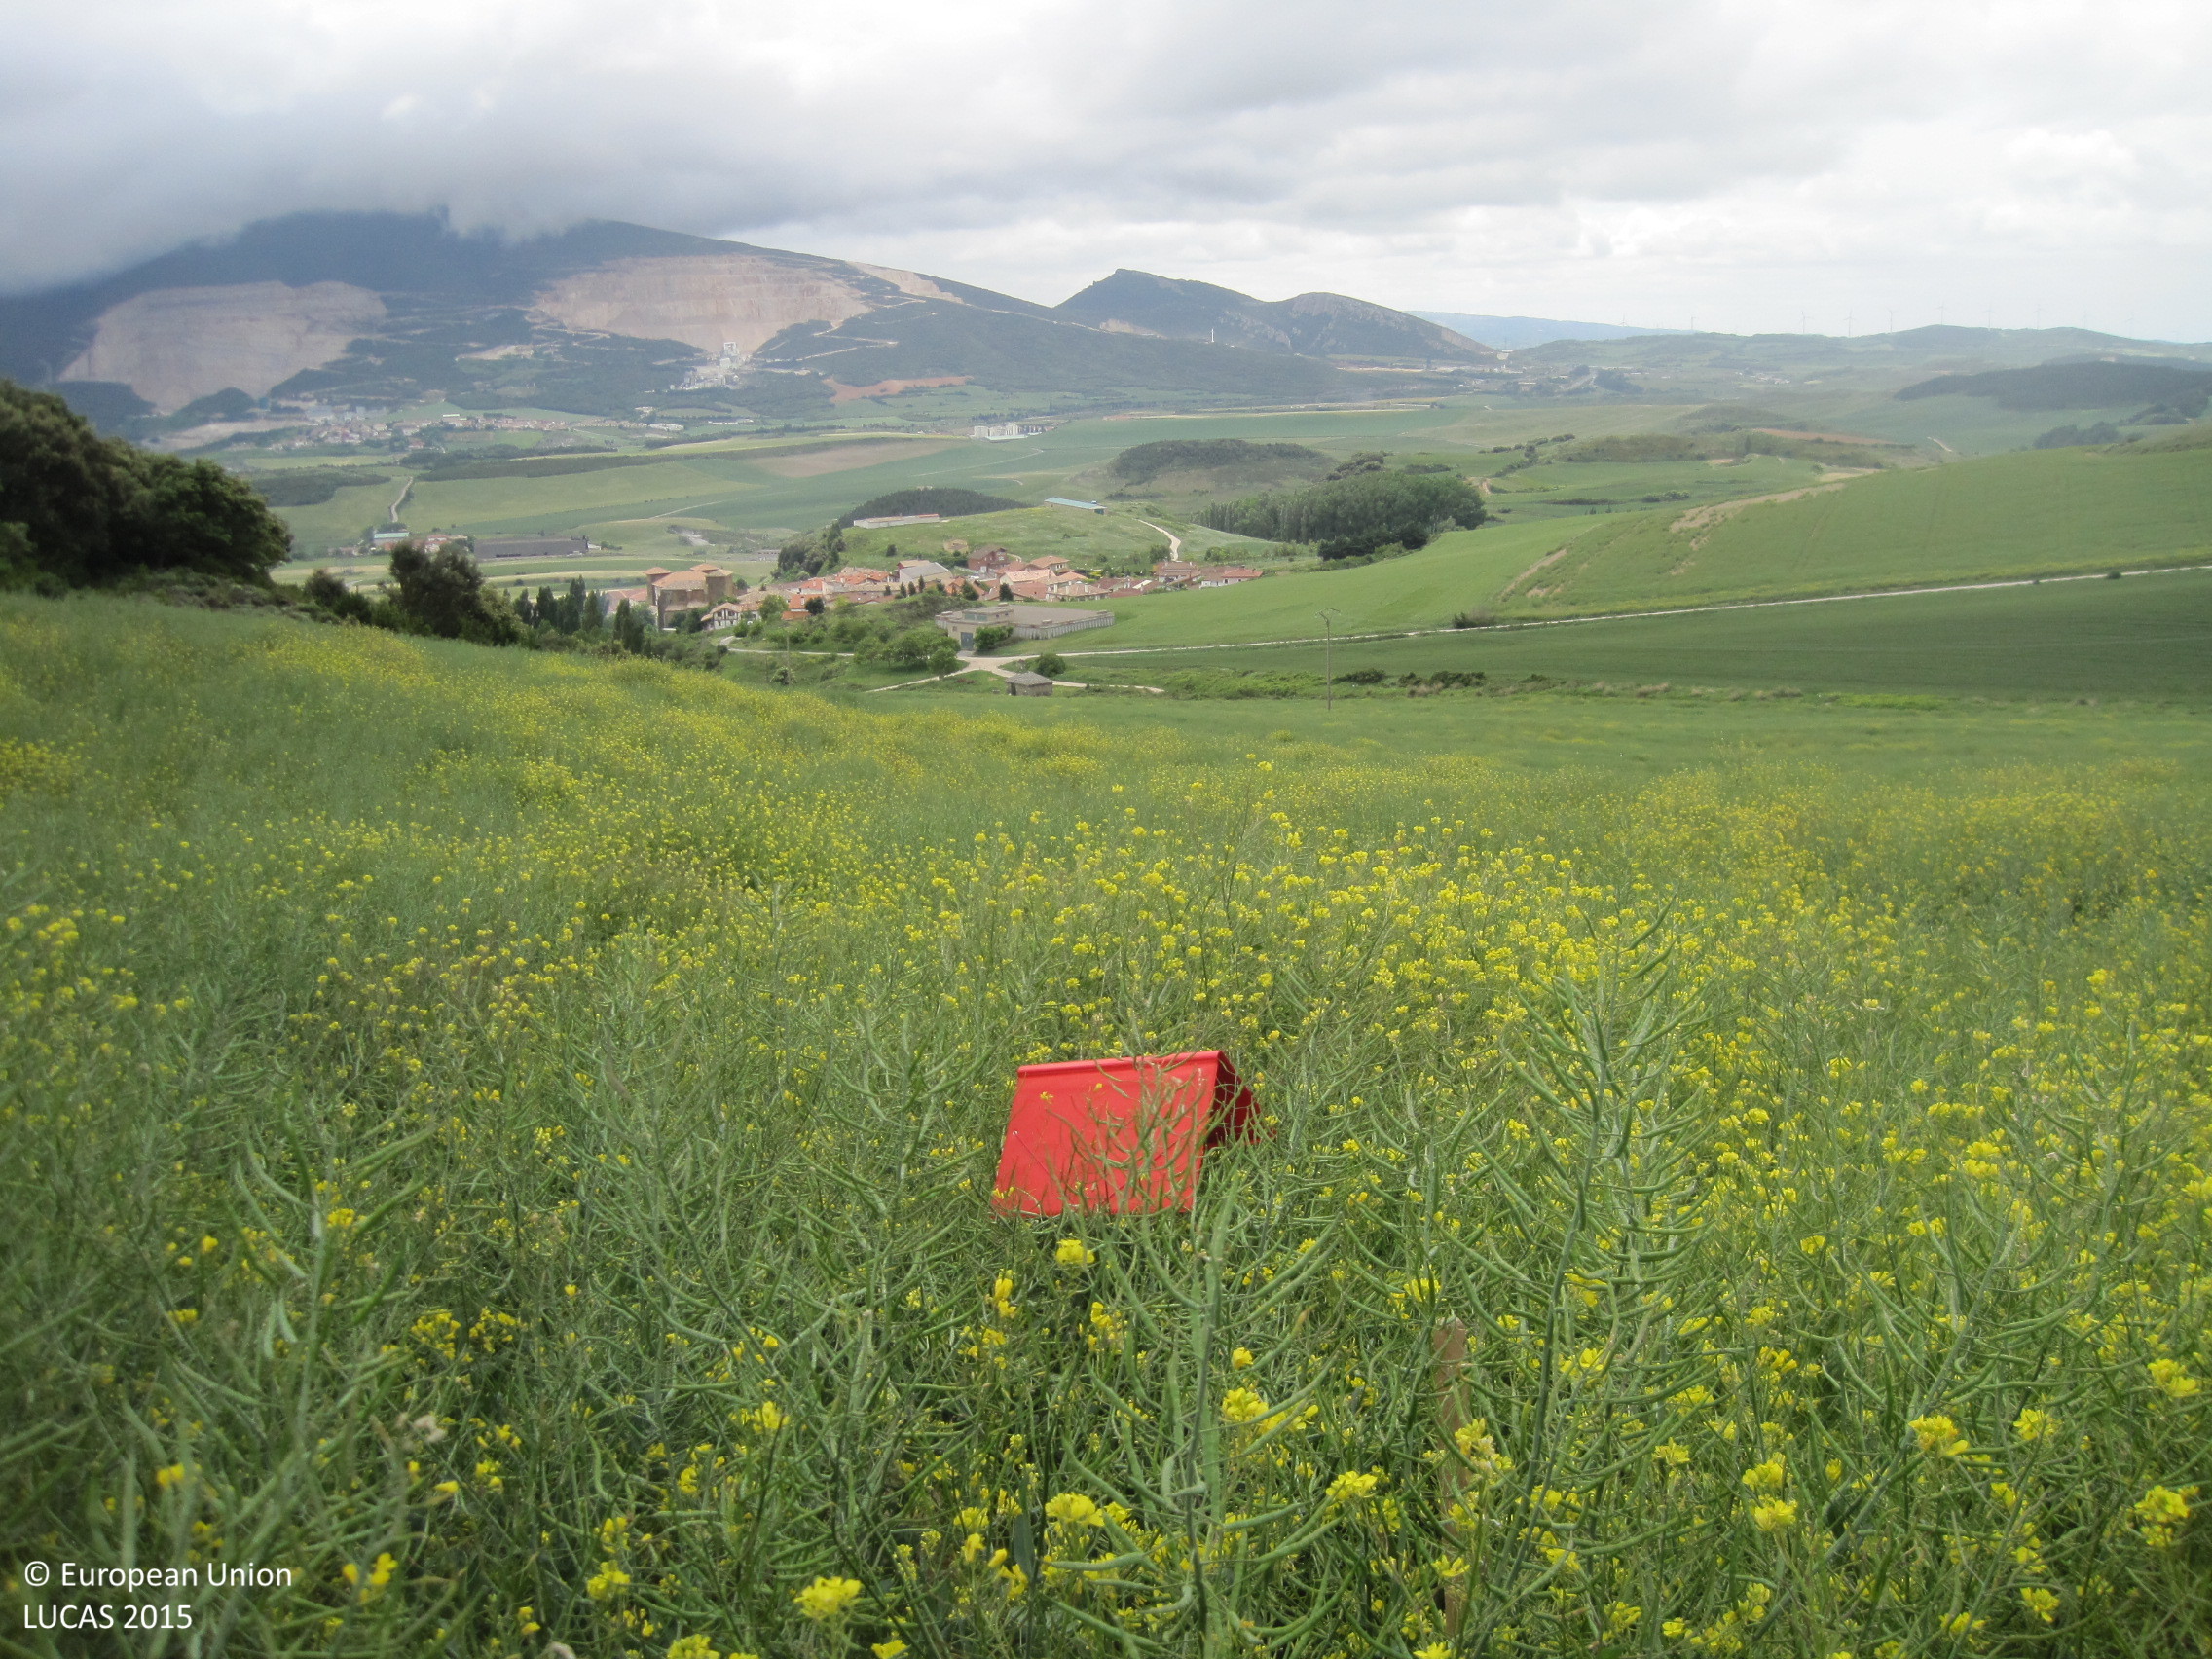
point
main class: Cropland
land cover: Rape and turnip rape
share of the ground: > 75 %
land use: Agriculture (excluding fallow land and kitchen gardens)
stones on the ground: < 10 %
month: May
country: ES
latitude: 42.7235
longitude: -1.6768
